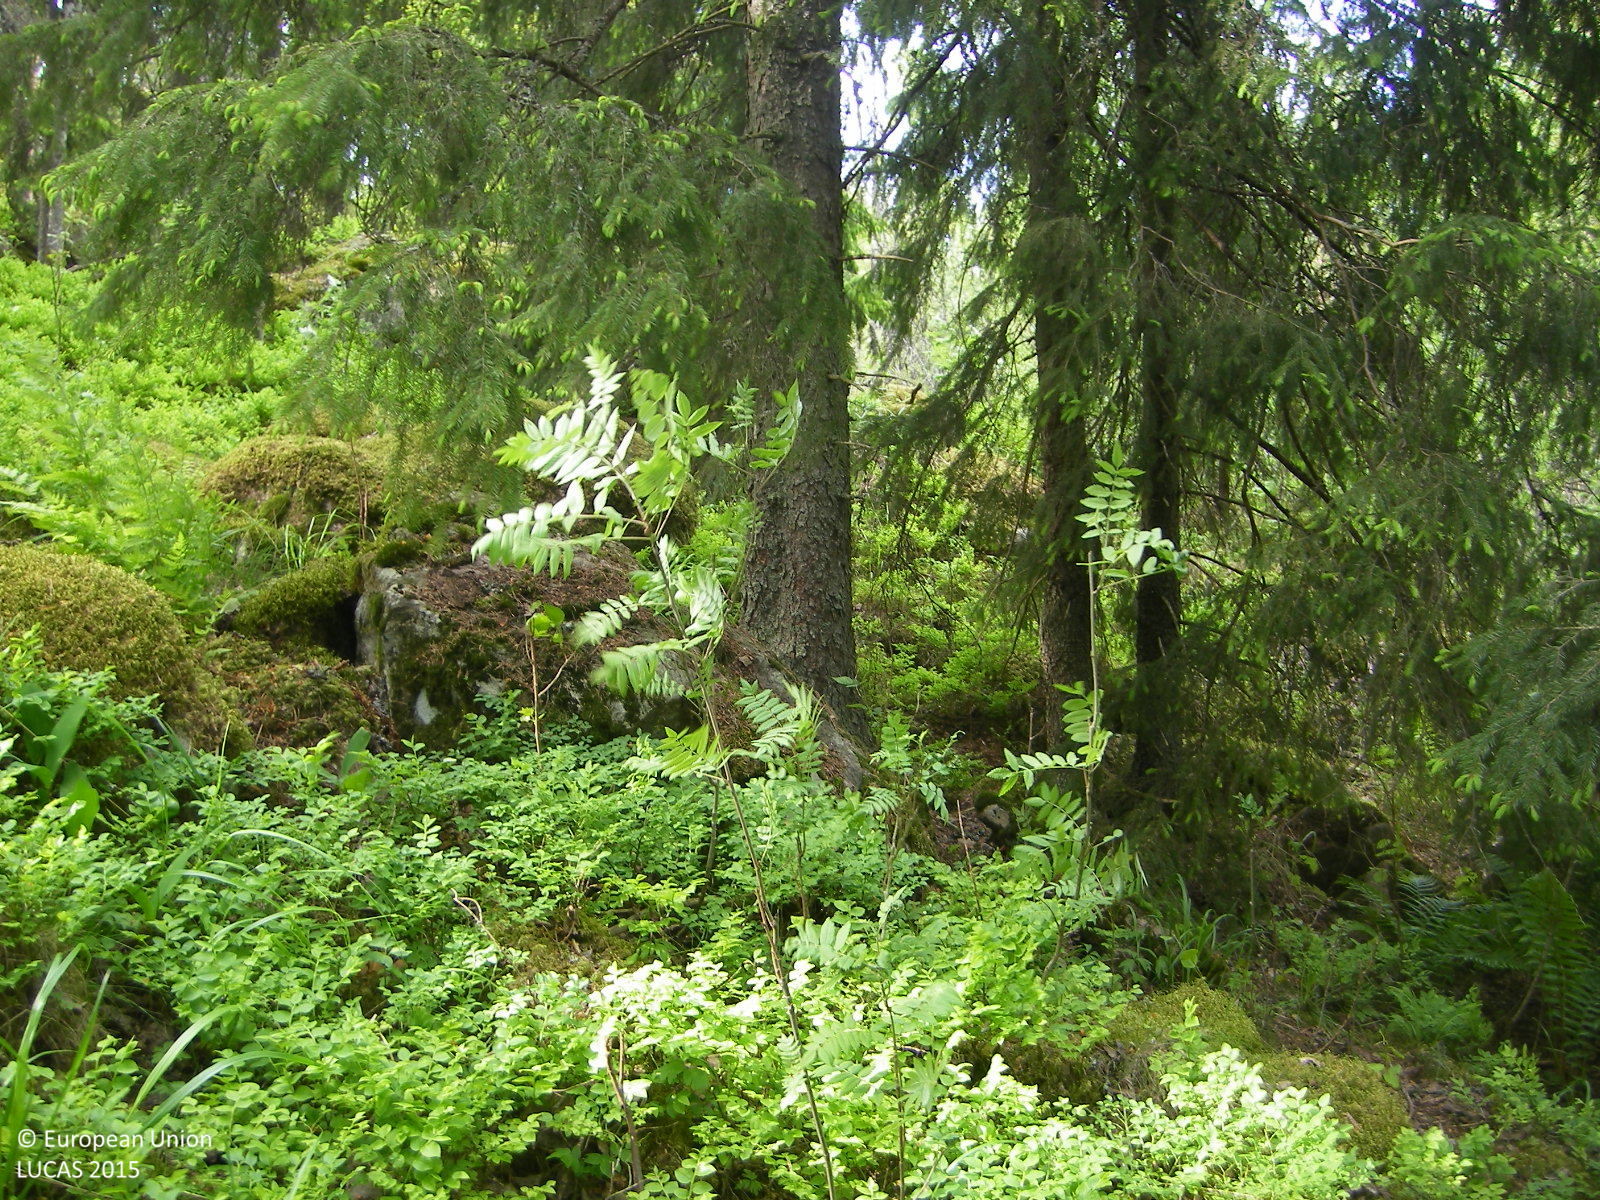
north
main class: Woodland
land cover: Spruce dominated mixed woodland
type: boreal forest
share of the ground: 50 - 75 %
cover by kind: broadleaved forest trees 40 %, coniferous forest trees 30 %, shrubs 15 %, herbaceous plants 10 %, lichens and mosses 5 %
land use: Forestry
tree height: > 5 m
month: June
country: FI
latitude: 60.3514
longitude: 24.7746
